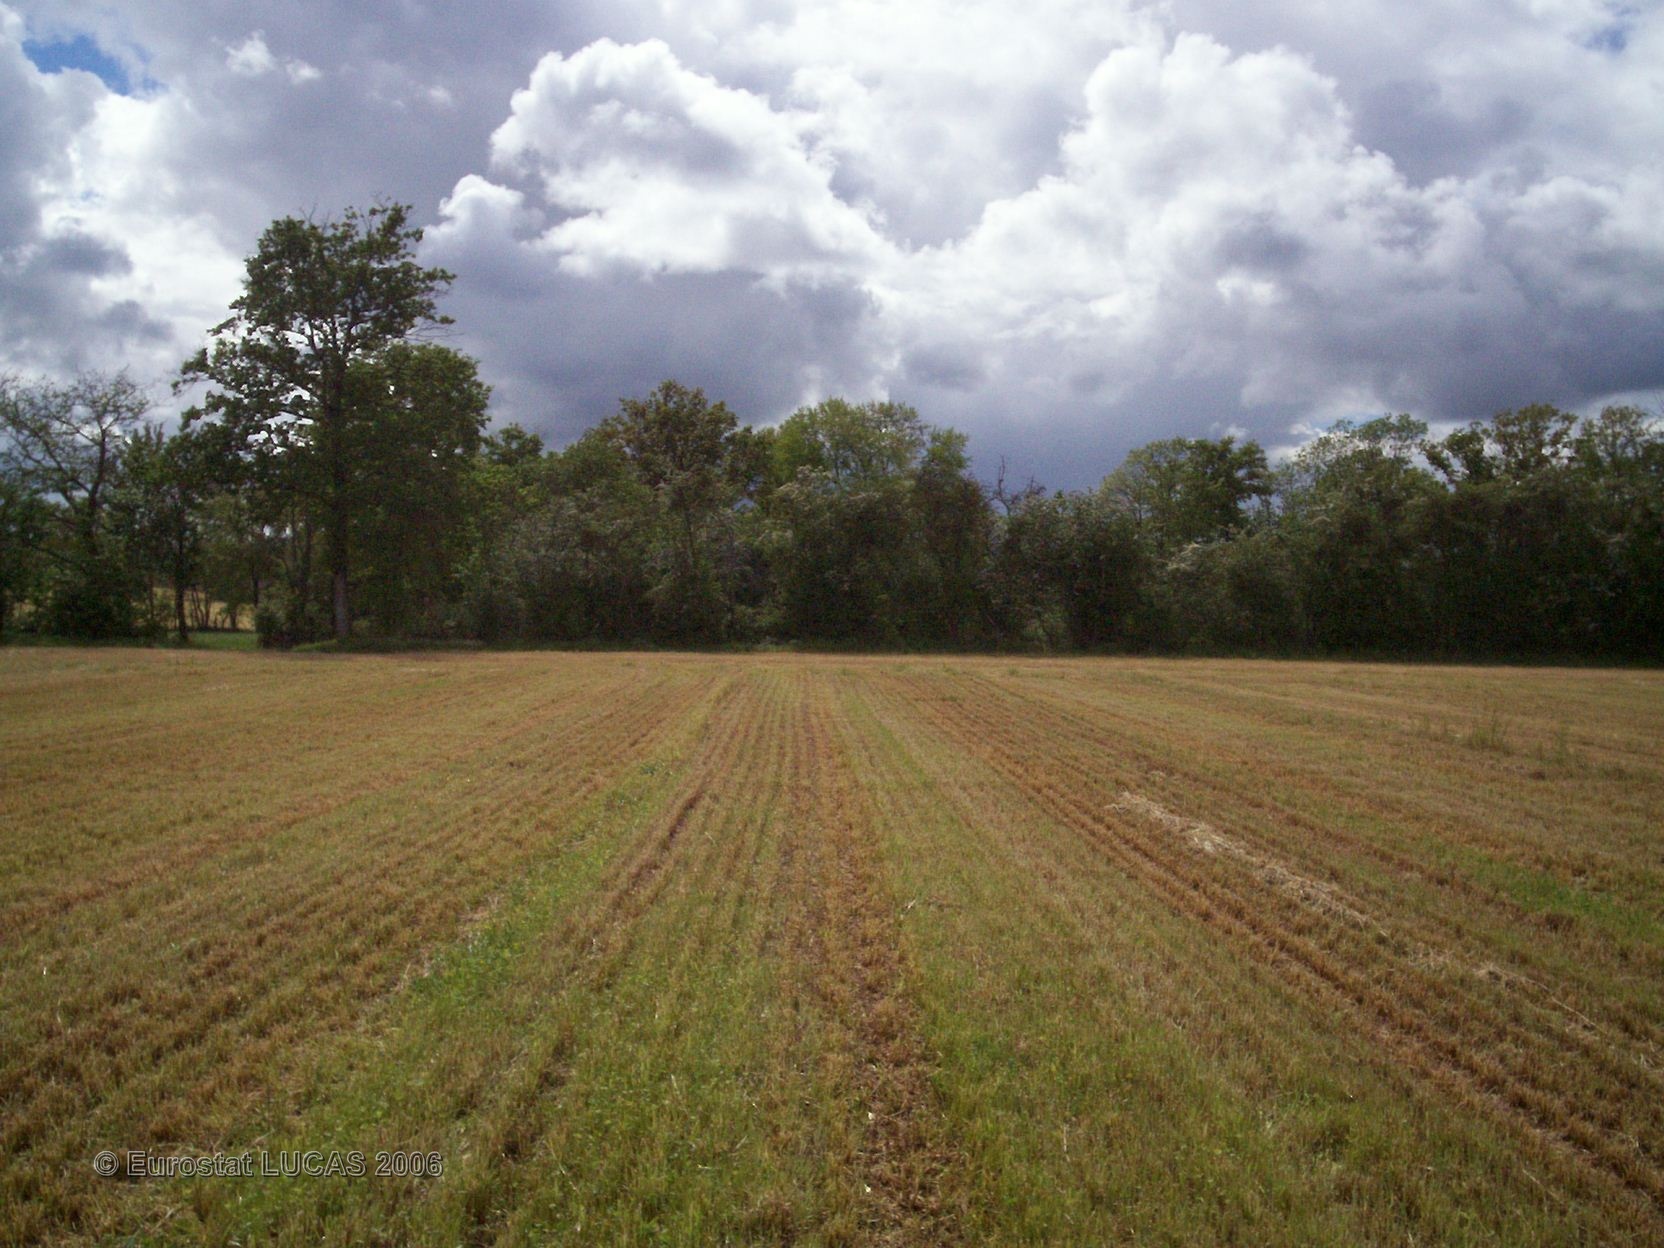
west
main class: Grassland
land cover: Grassland without tree/shrub cover
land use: Agriculture (excluding fallow land and kitchen gardens)
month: May
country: FR
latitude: 46.6173
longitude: -0.2756
